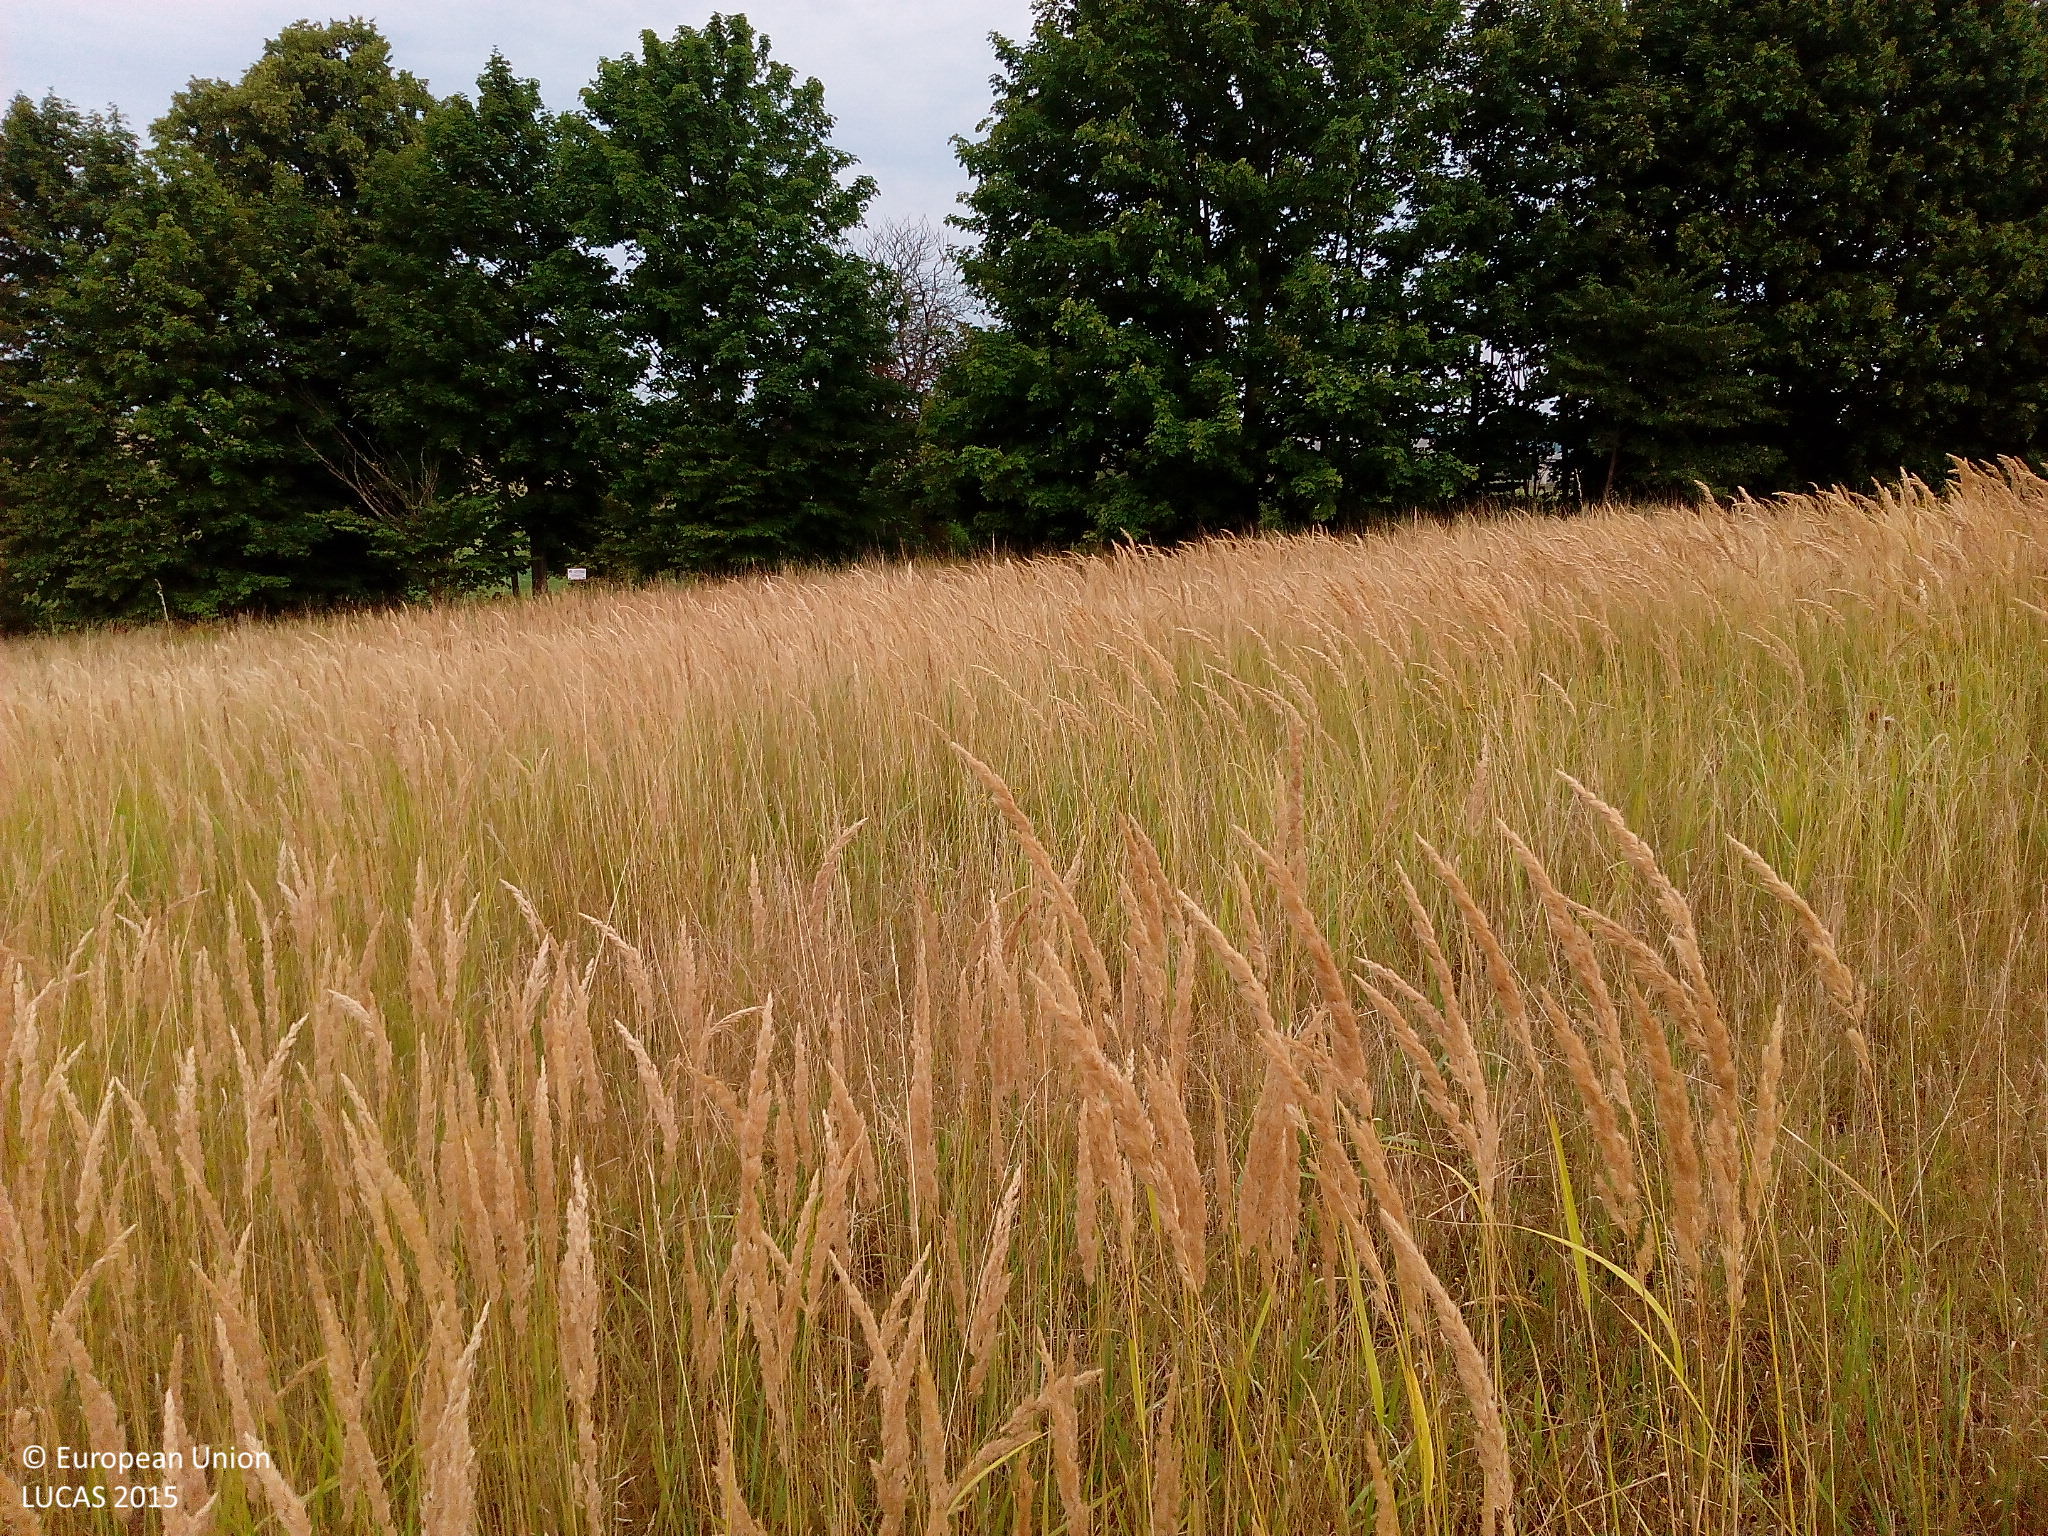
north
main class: Grassland
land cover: Grassland without tree/shrub cover
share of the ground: > 75 %
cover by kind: herbaceous plants 100 %
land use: Agriculture (excluding fallow land and kitchen gardens)
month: August
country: DE
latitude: 54.1104
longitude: 12.6453
